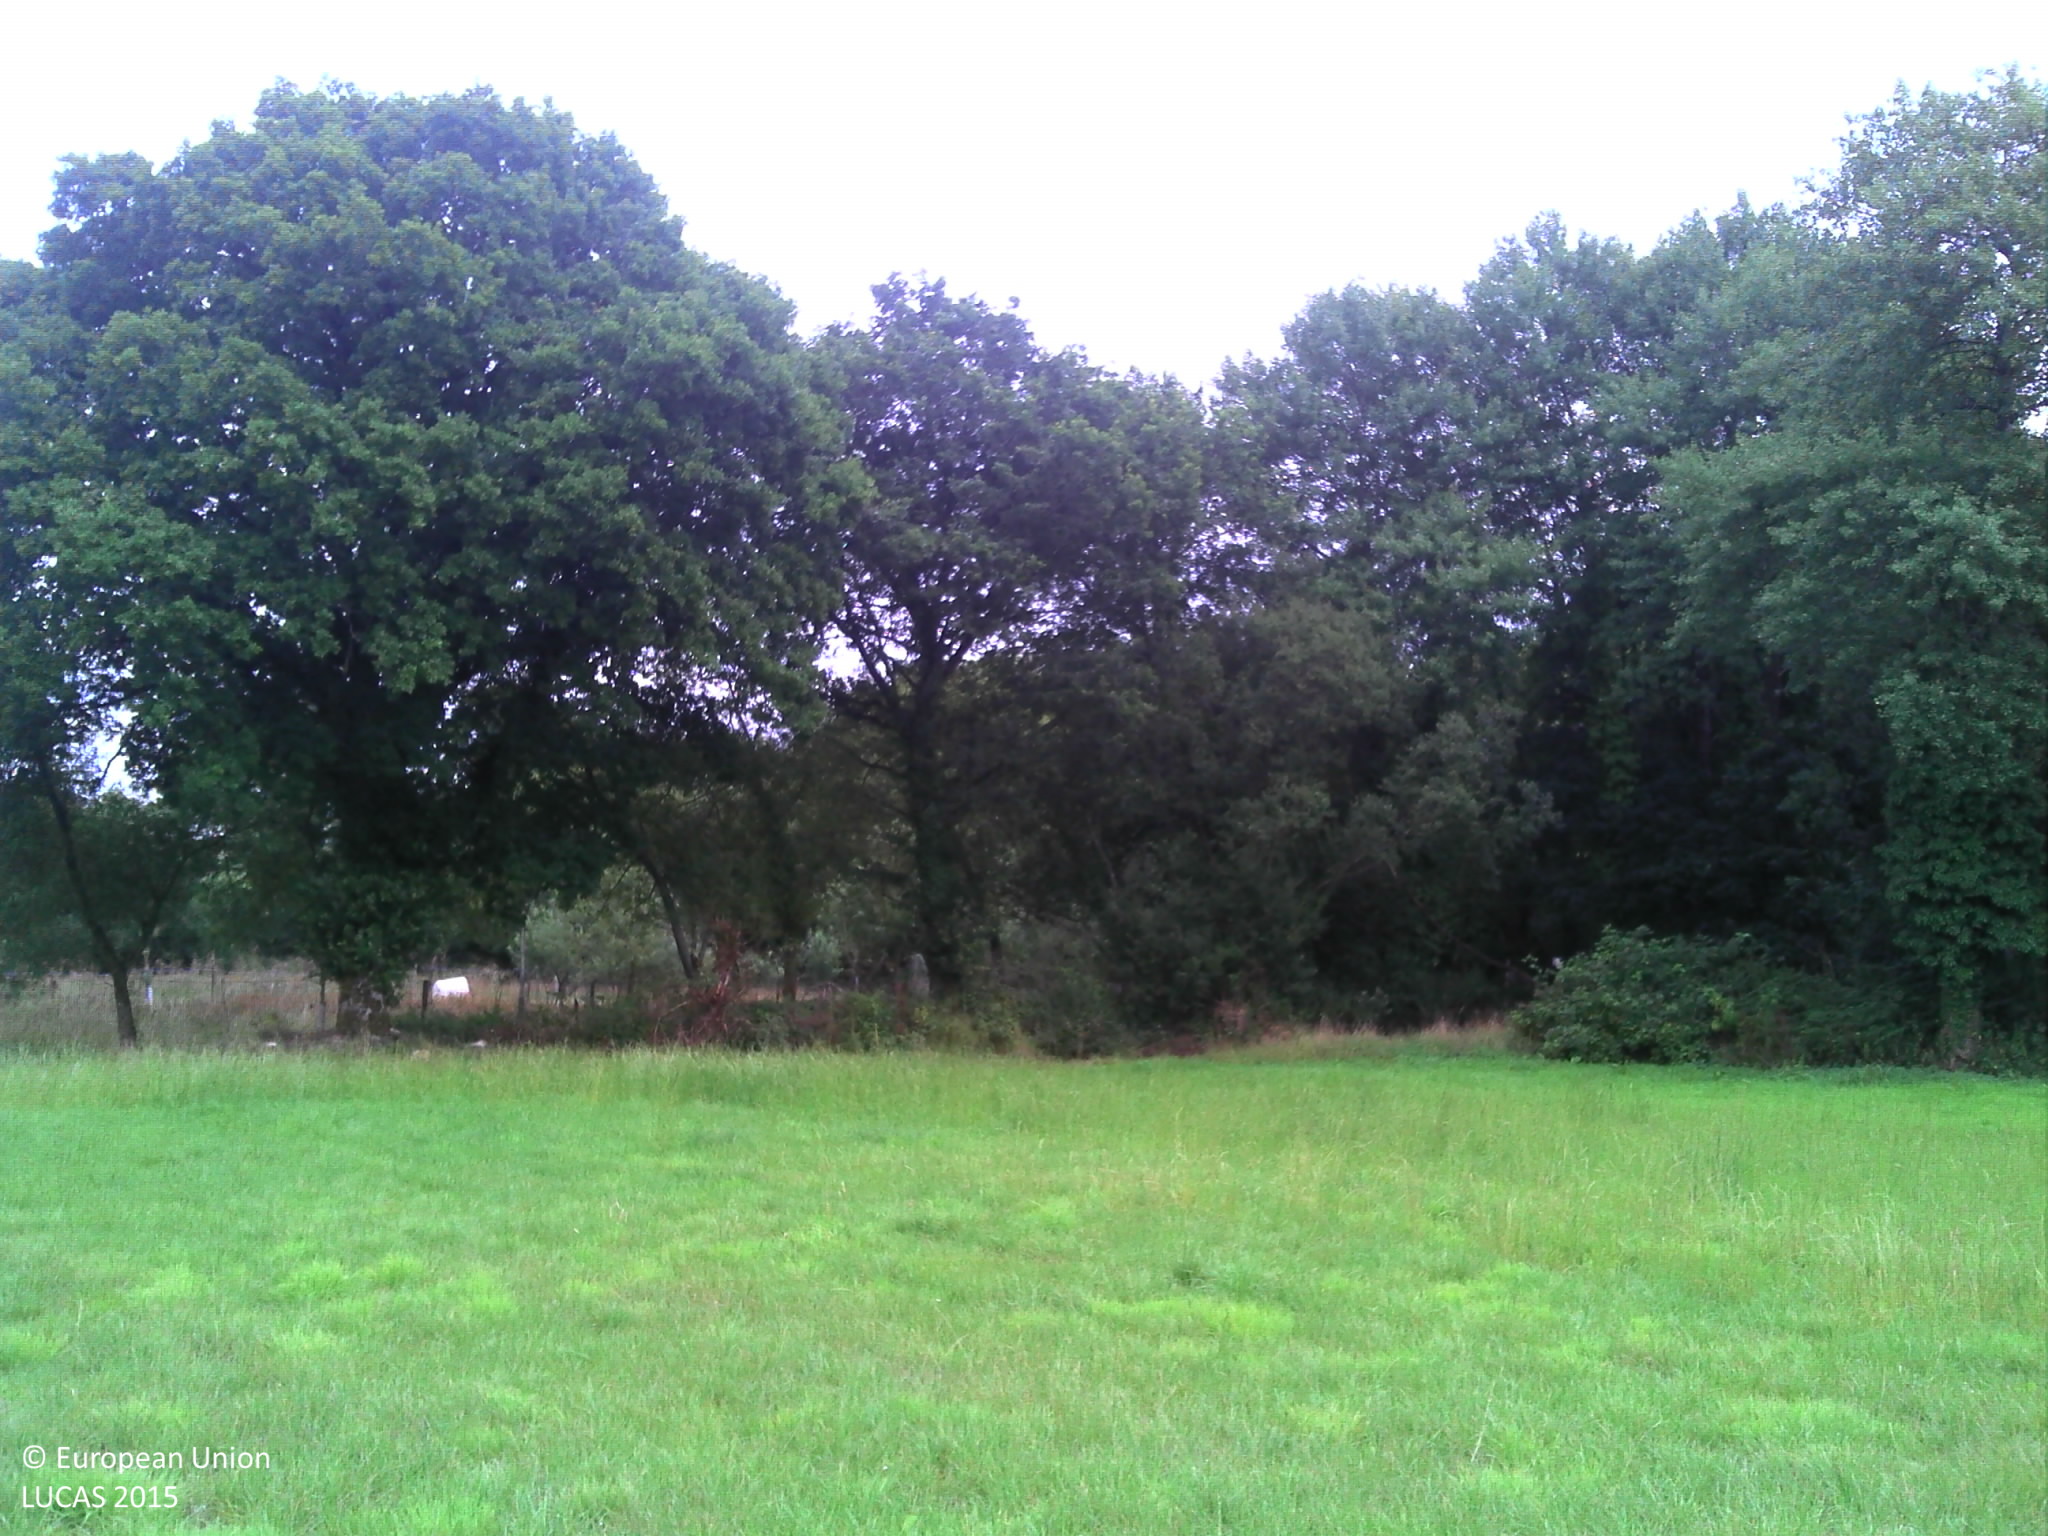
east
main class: Cropland
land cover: Temporary grasslands
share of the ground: > 75 %
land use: Agriculture (excluding fallow land and kitchen gardens)
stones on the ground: < 10 %
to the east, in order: Temporary grasslands; Lines of trees; Fences; Grassland without tree/shrub cover; Fences; Grassland without tree/shrub cover; Broadleaved woodland; Spontaneously vegetated surfaces; Shrubland without tree cover; Broadleaved woodland
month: August
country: FR
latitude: 48.2937
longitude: -3.4072
